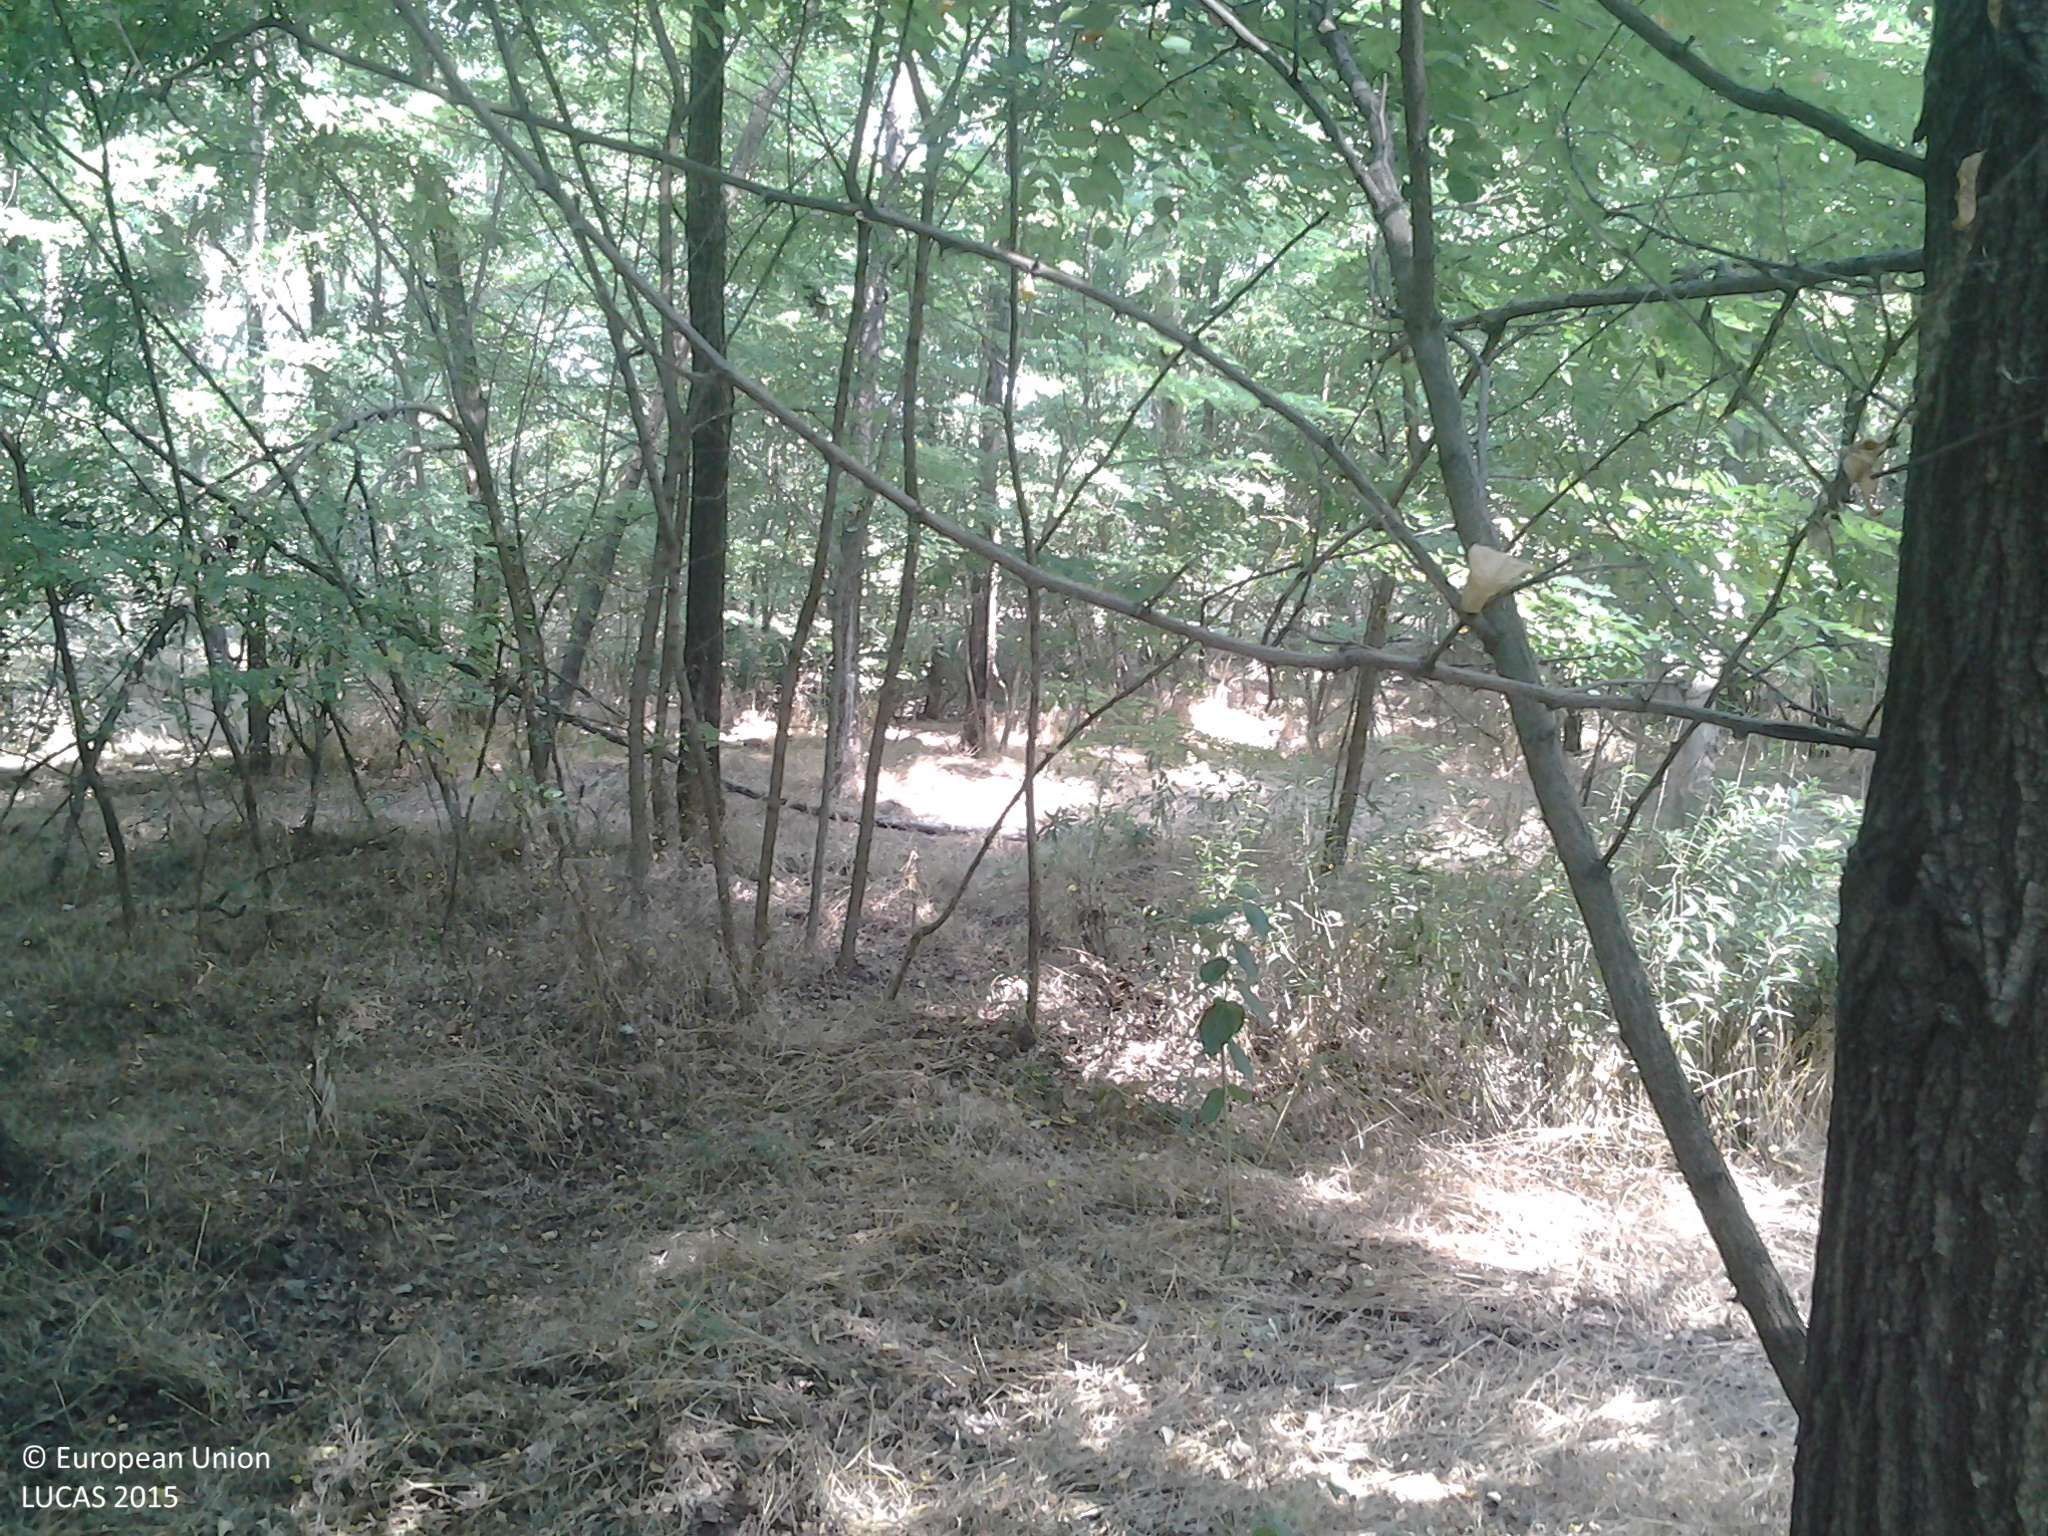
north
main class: Woodland
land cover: Broadleaved woodland
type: exotic forest
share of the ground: 50 - 75 %
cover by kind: broadleaved forest trees 70 %, herbaceous plants 30 %
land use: Forestry
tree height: > 5 m
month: July
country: HU
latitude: 46.8767
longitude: 19.0030
